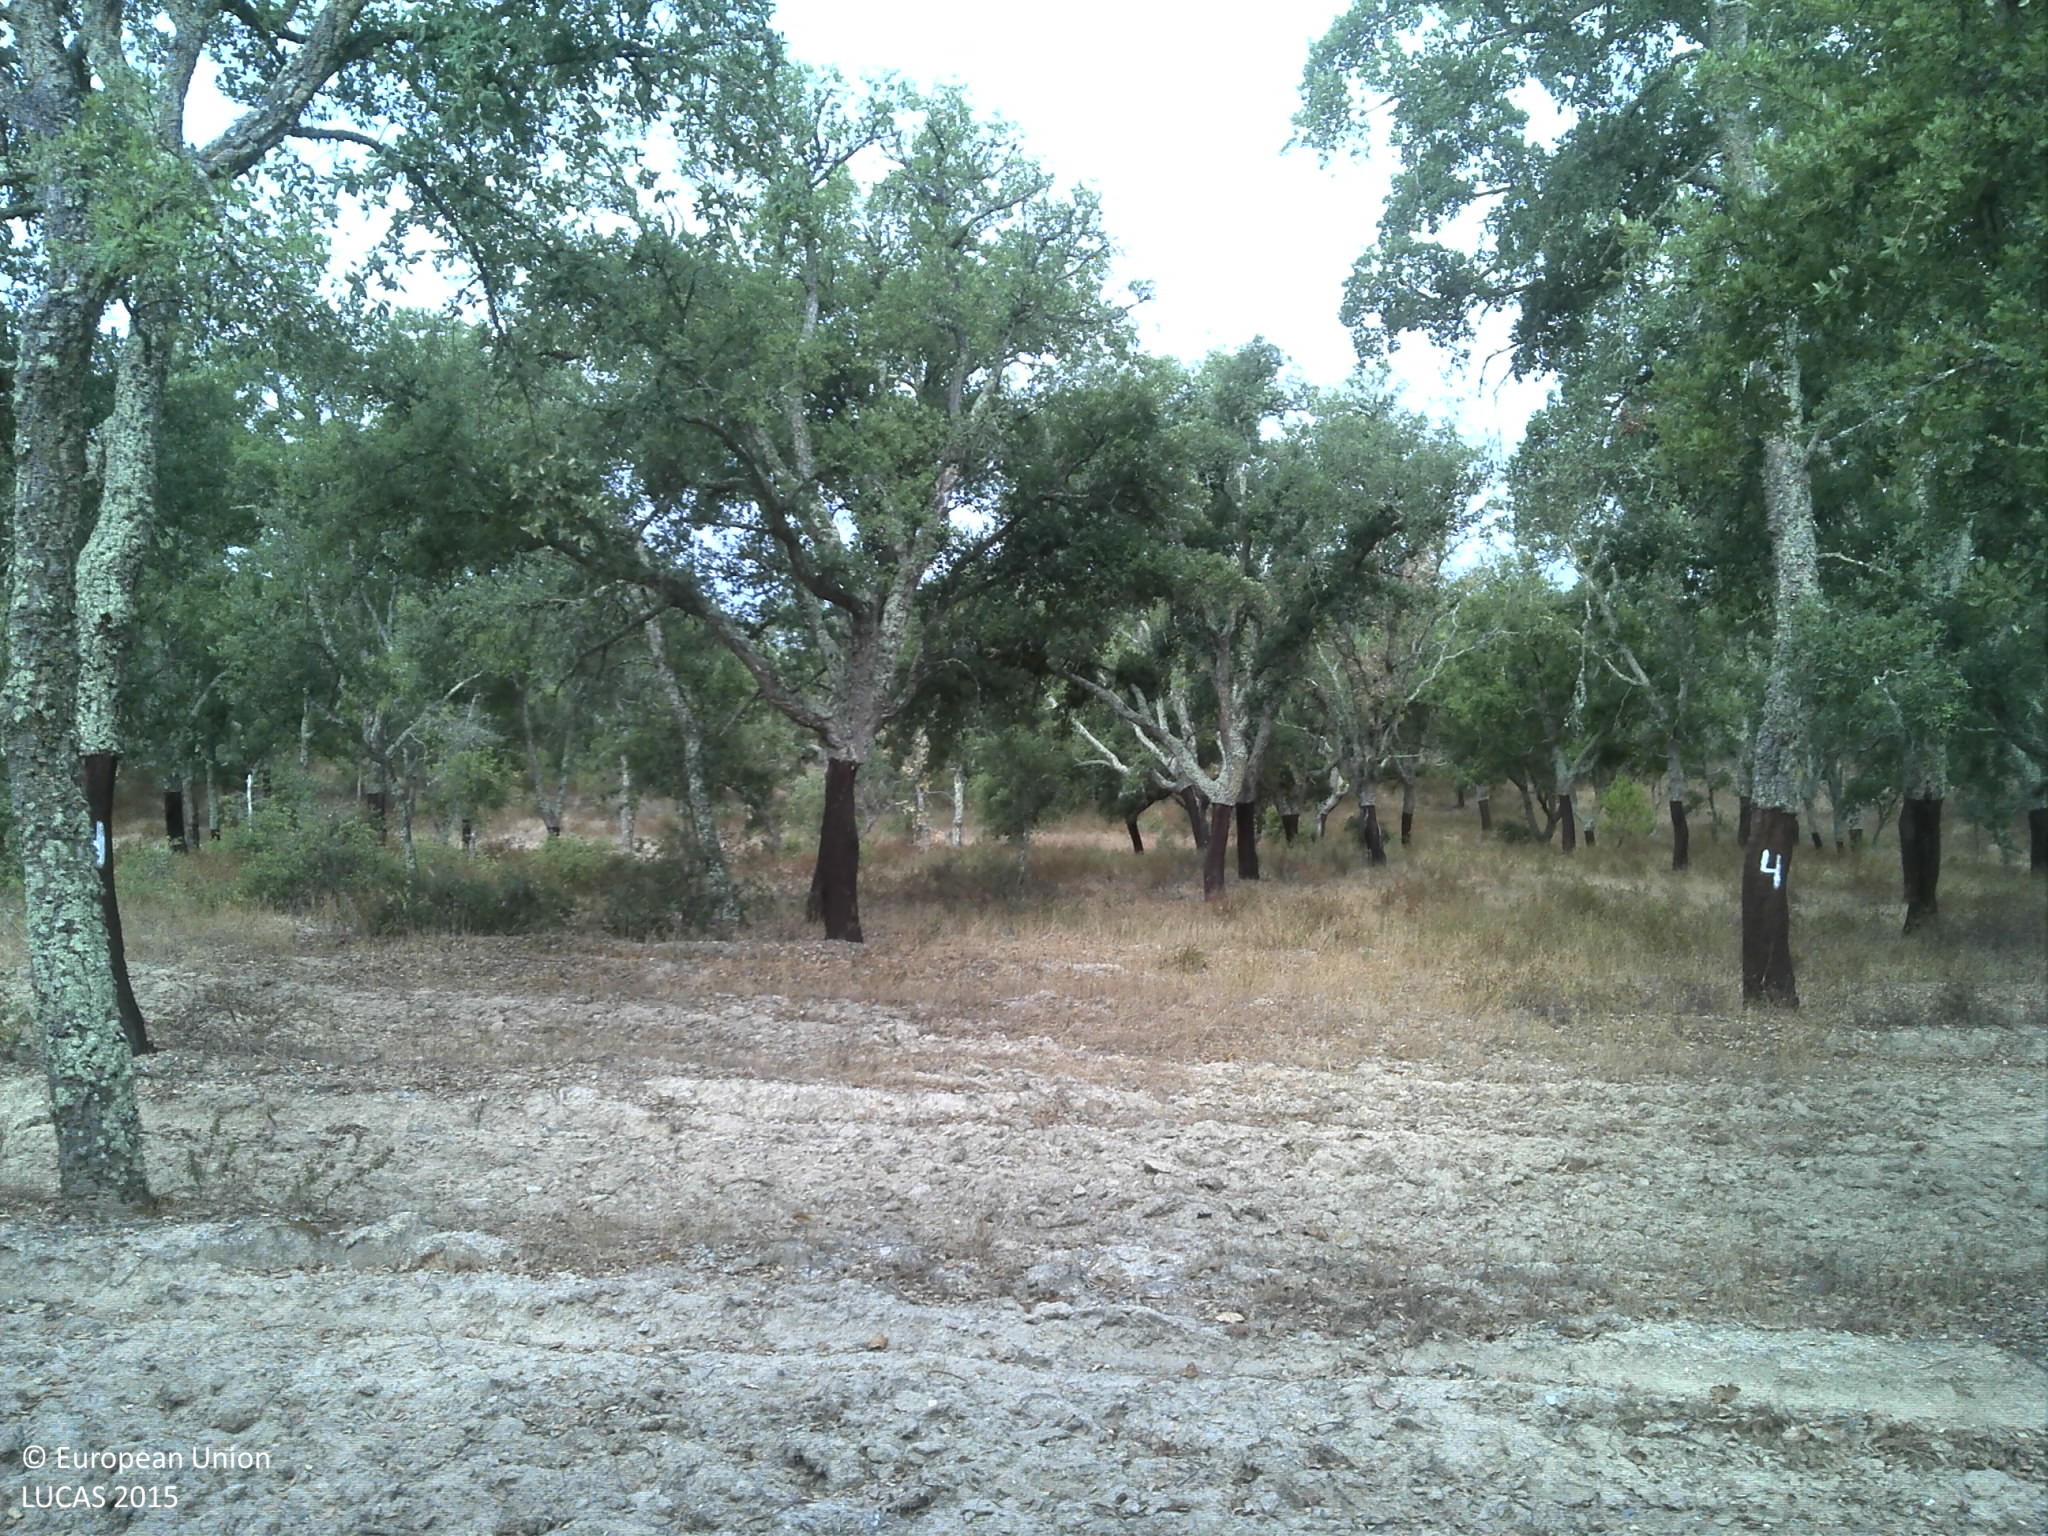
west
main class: Woodland
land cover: Broadleaved woodland
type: broadleaved evergreen forest
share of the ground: 50 - 75 %
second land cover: Grassland without tree/shrub cover
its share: 25 - 50 %
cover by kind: broadleaved forest trees 60 %, herbaceous plants 30 %, unconsolidated bare surface 10 %
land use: Forestry
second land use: Agriculture (excluding fallow land and kitchen gardens)
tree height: > 5 m
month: July
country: PT
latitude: 38.9200
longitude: -8.6698
